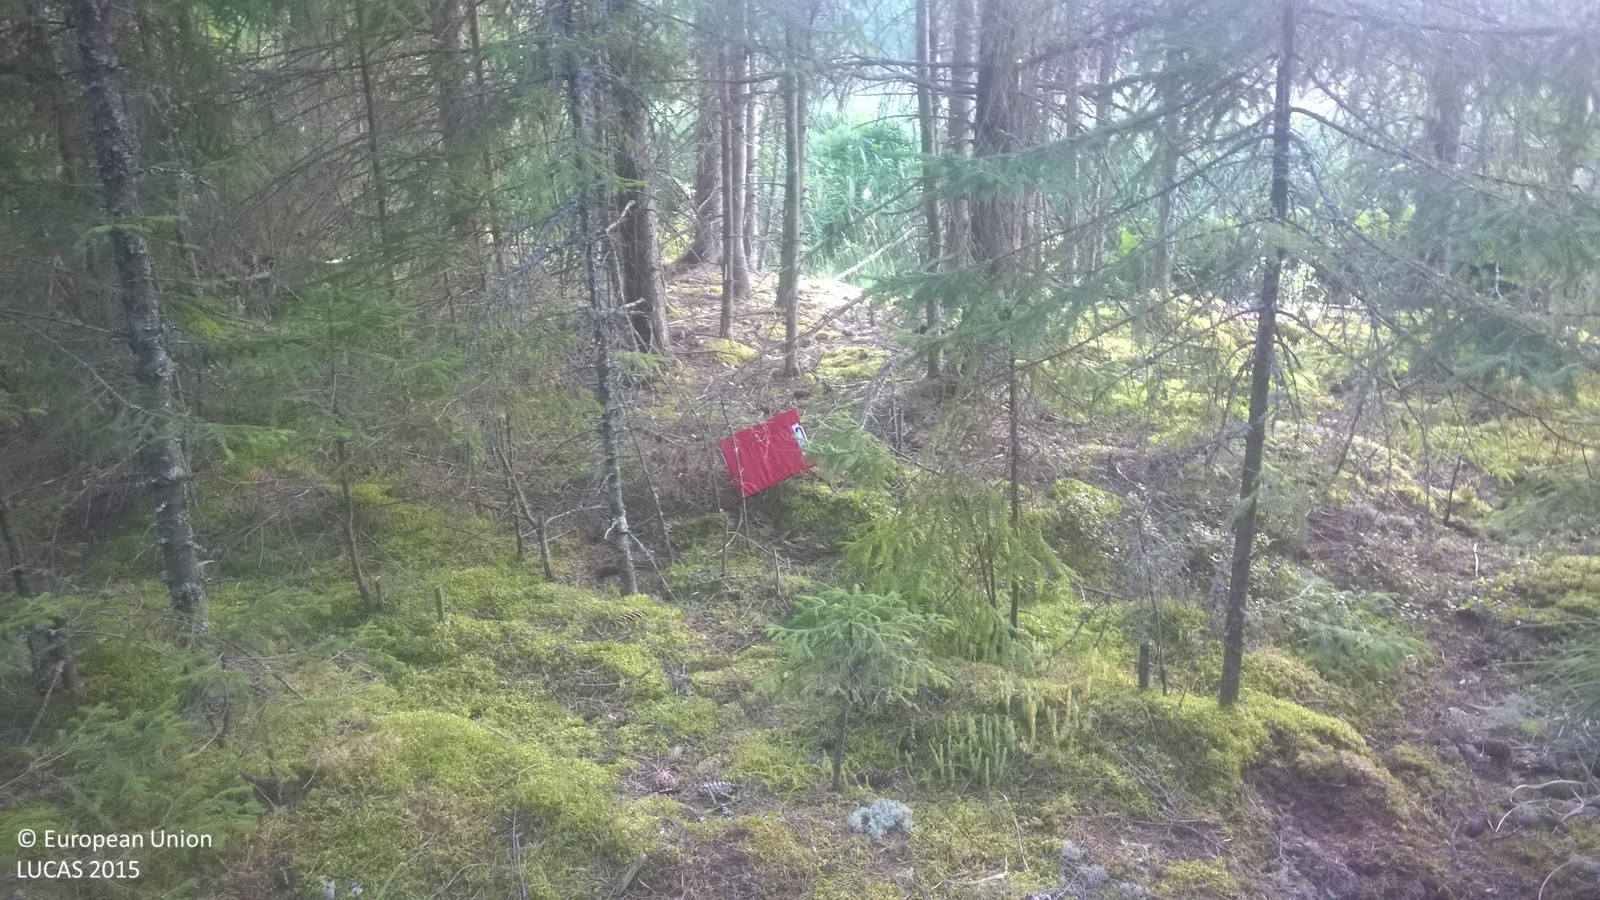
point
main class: Woodland
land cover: Spruce dominated coniferous woodland
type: hemiboreal forest and nemoral coniferous forest and mixed broadleaved-coniferous forest
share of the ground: > 75 %
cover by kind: coniferous forest trees 85 %, lichens and mosses 10 %, unconsolidated bare surface 5 %
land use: Forestry
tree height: > 5 m
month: August
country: LV
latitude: 57.6523
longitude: 26.0308
